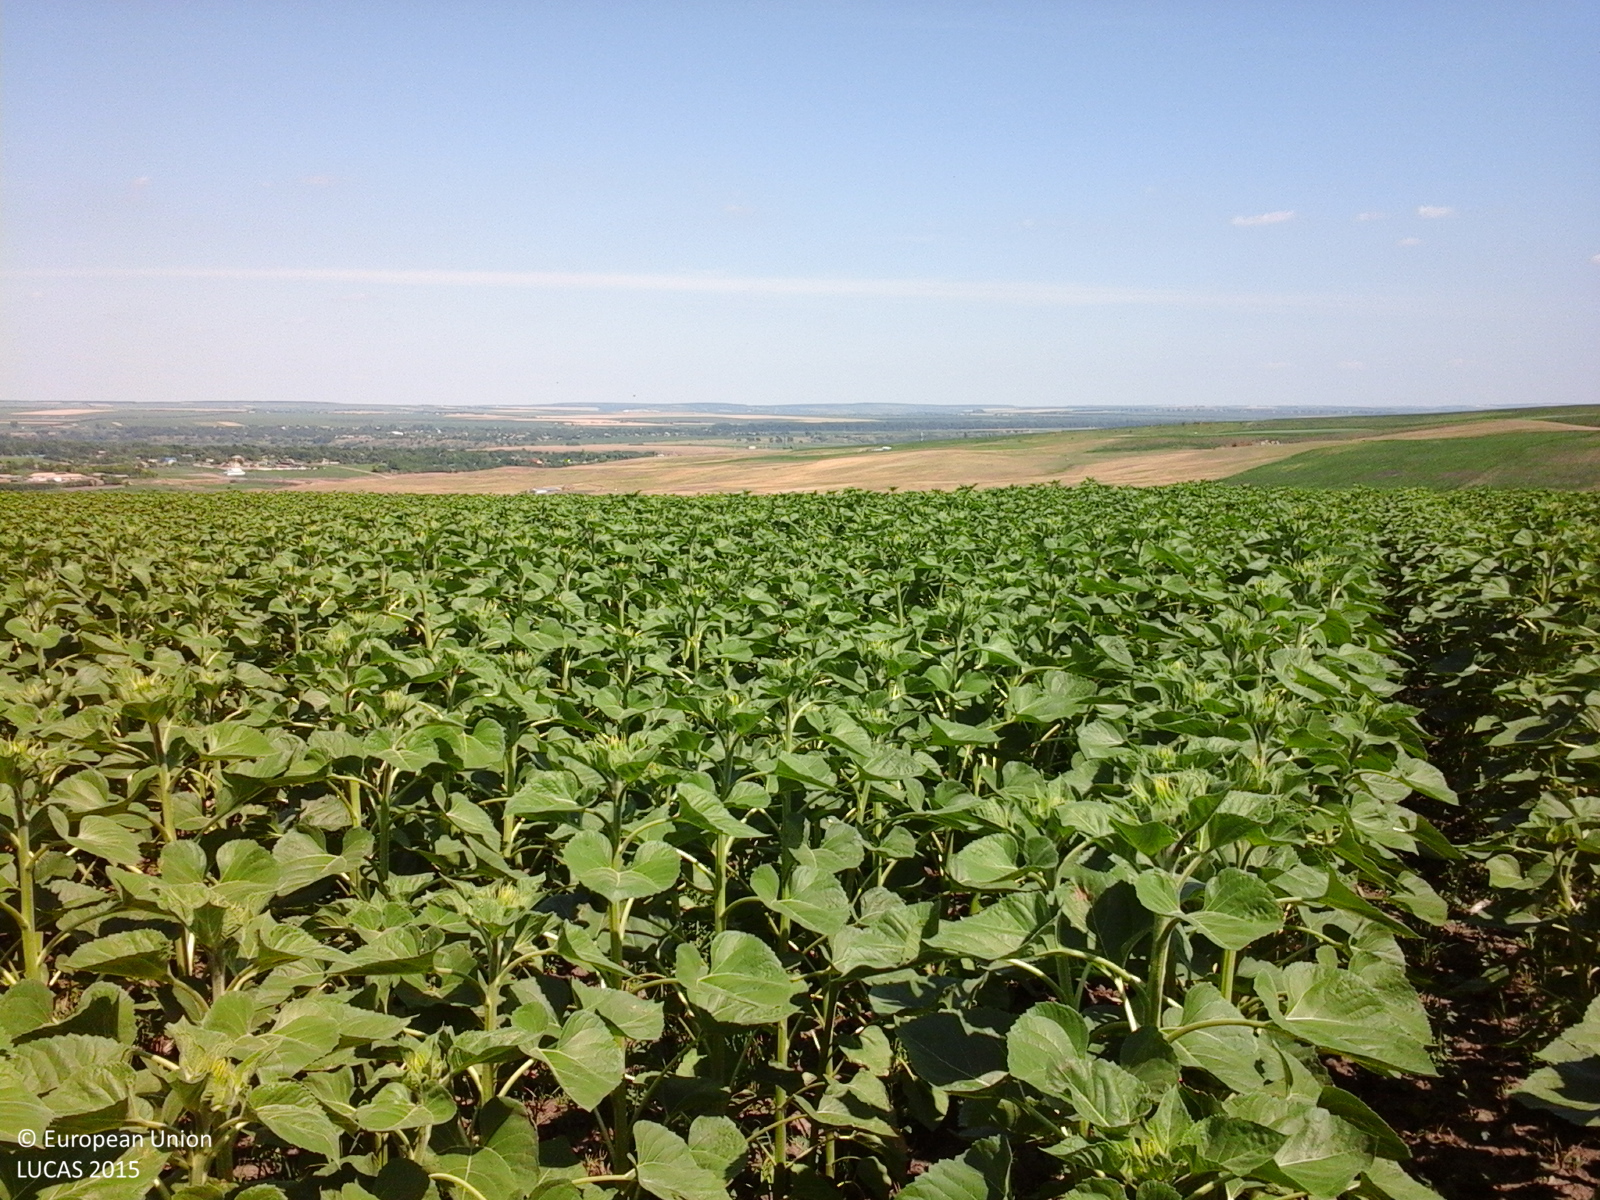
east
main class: Cropland
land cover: Sunflower
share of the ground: > 75 %
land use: Agriculture (excluding fallow land and kitchen gardens)
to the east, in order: Sunflower; Grass margins; Tracks; Grass margins; Sunflower
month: June
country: RO
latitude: 48.0881
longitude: 26.9822
